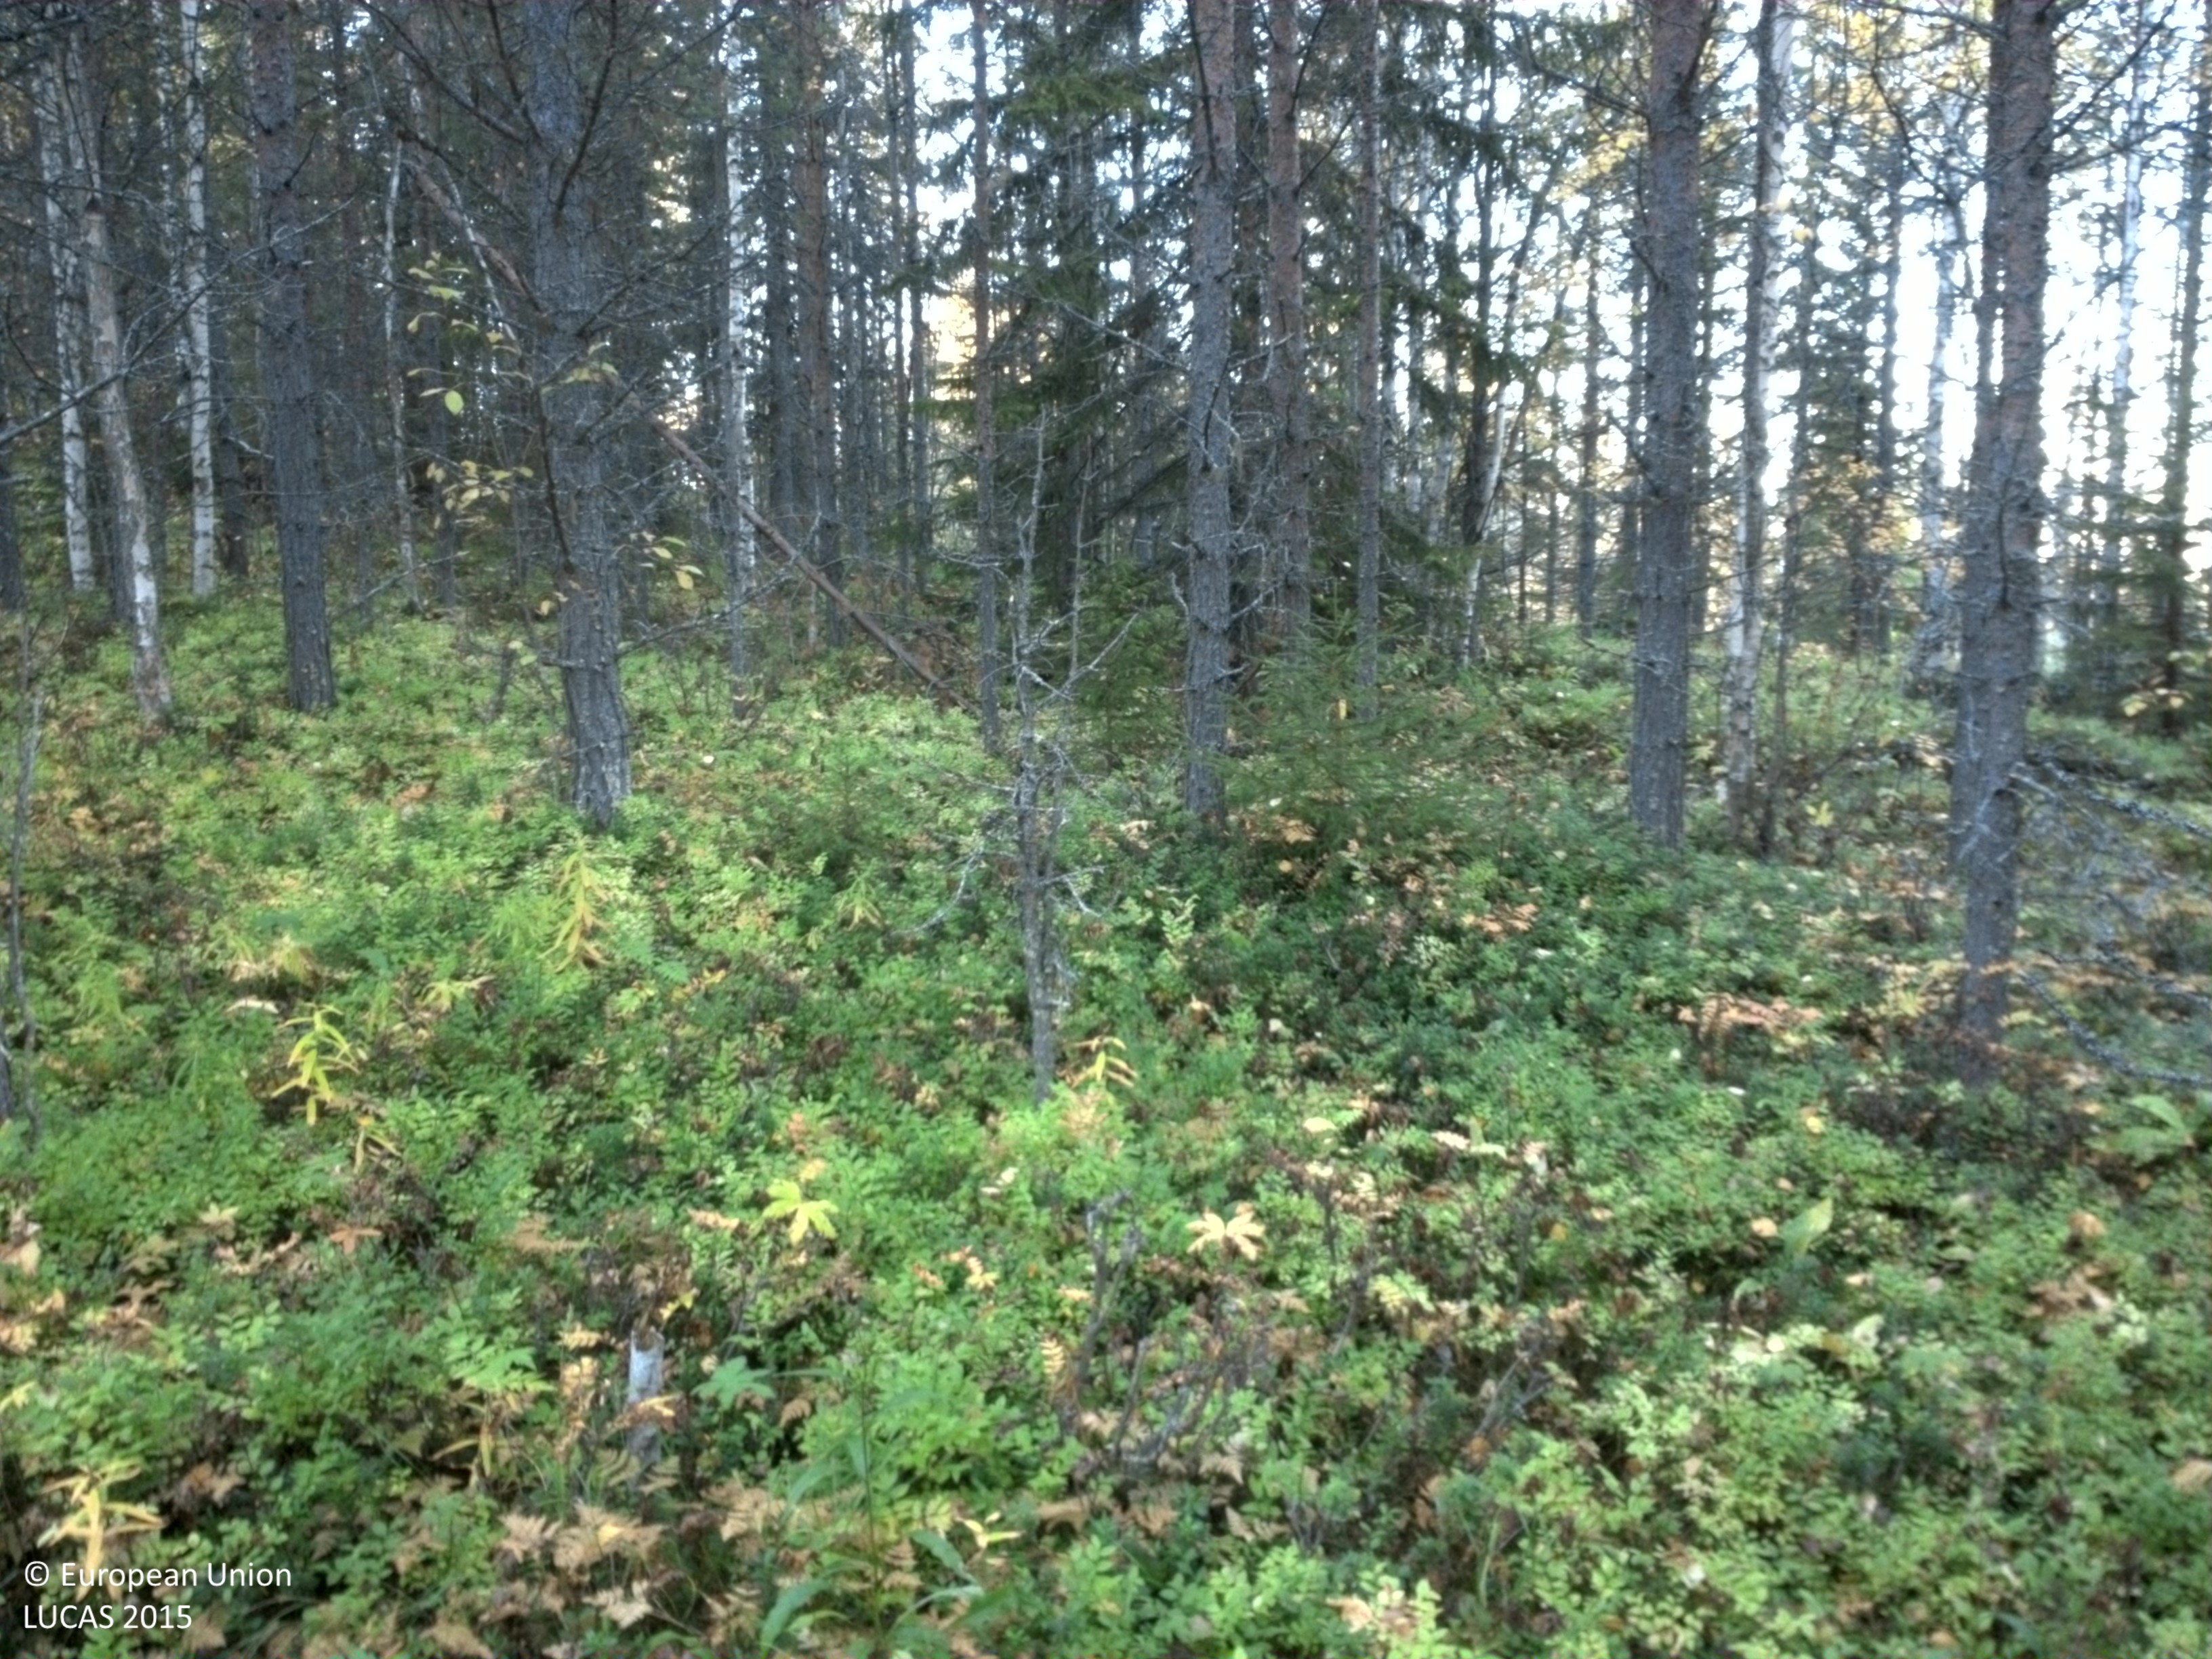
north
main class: Woodland
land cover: Pine dominated coniferous woodland
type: boreal forest
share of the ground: 50 - 75 %
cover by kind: coniferous forest trees 45 %, shrubs 35 %, broadleaved forest trees 10 %, herbaceous plants 10 %
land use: Forestry
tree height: > 5 m
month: September
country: SE
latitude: 64.9342
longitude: 17.7702
